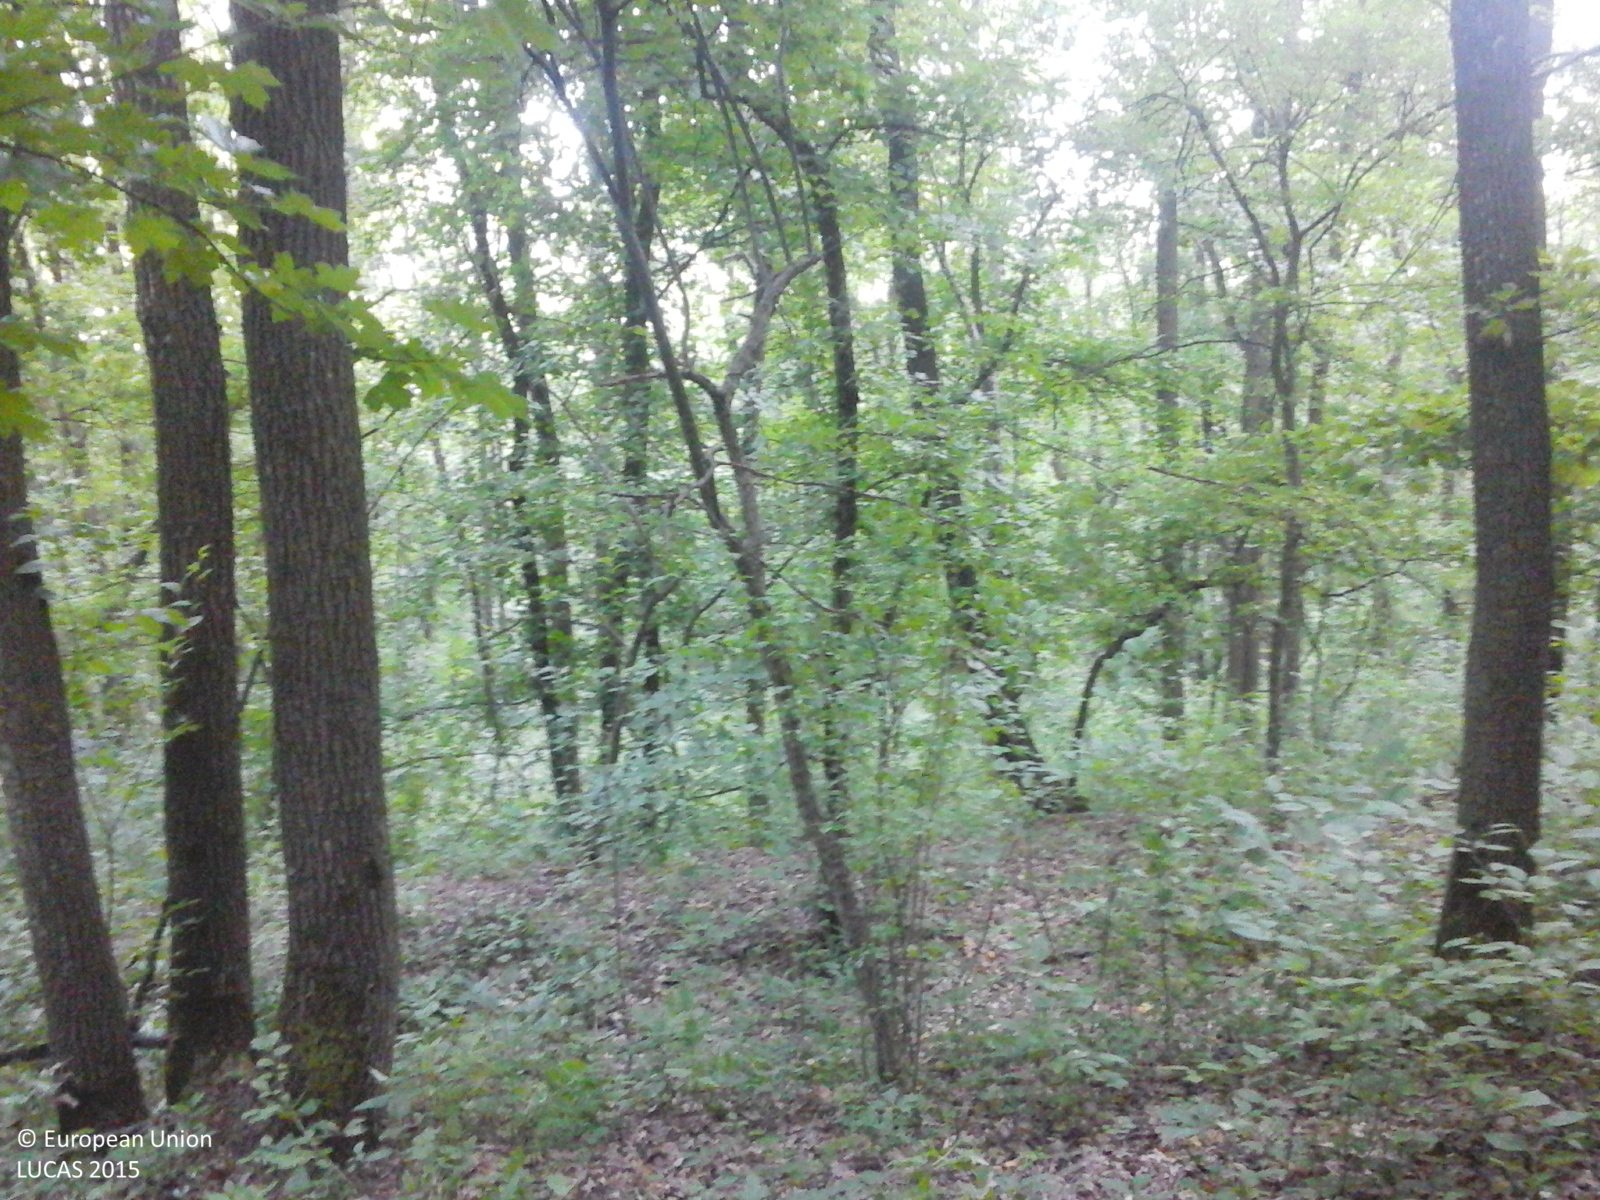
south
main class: Woodland
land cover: Broadleaved woodland
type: mesophytic deciduous forest
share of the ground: > 75 %
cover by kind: broadleaved forest trees 95 %, herbaceous plants 5 %
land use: Forestry
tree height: > 5 m
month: June
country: RO
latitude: 47.6247
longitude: 27.2367
